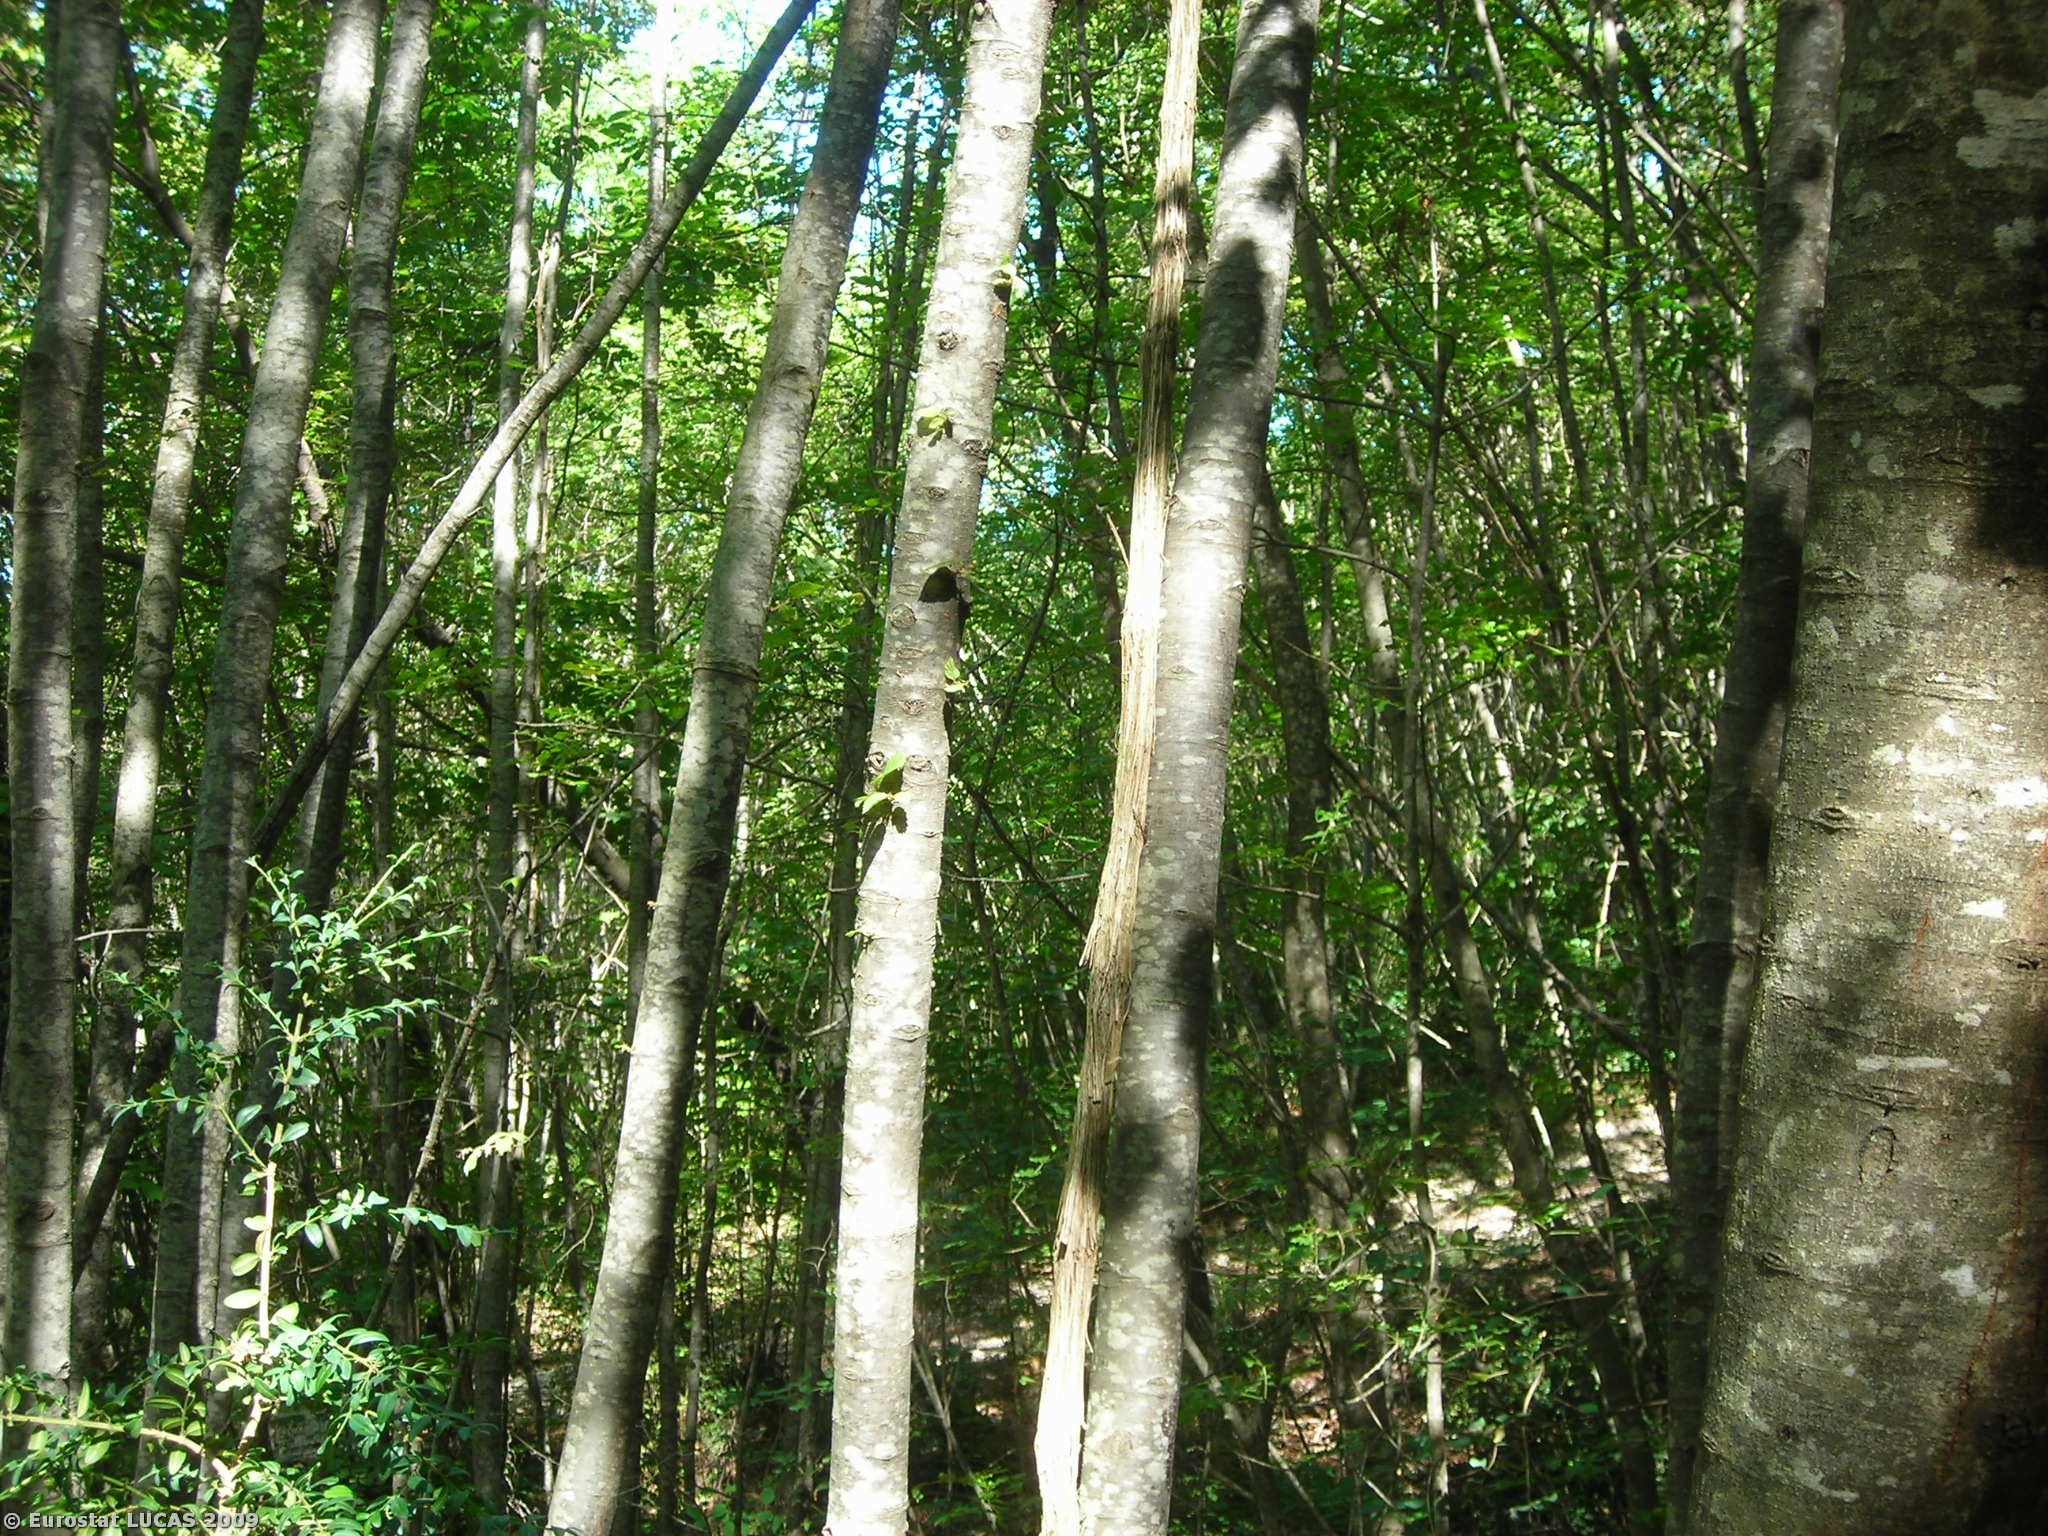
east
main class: Woodland
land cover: Broadleaved woodland
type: thermophilous deciduous forest
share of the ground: > 75 %
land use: Forestry
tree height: > 5 m
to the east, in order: Broadleaved woodland; Paved roads, cycling and walking lanes; Broadleaved woodland; Coniferous woodland; Cherry fruit; Grassland with sparse tree/shrub cover
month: July
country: IT
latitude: 43.3071
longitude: 13.2339
